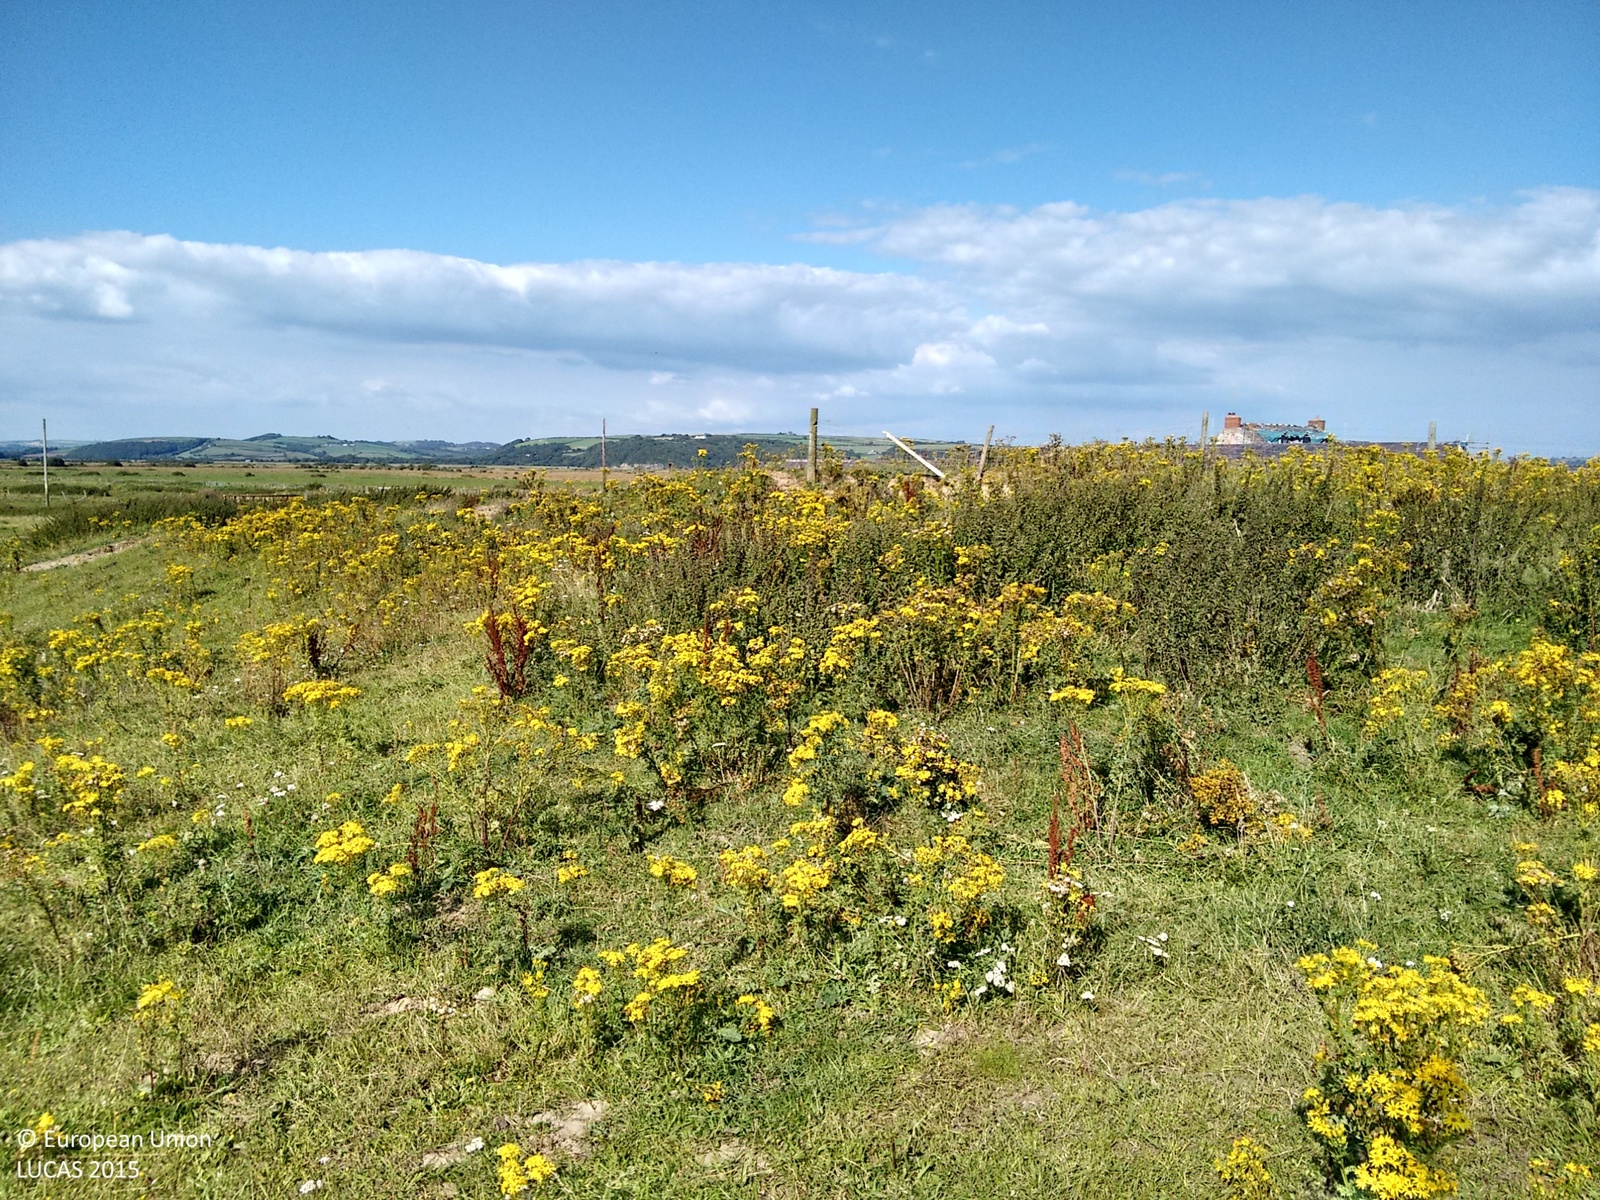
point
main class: Grassland
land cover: Grassland without tree/shrub cover
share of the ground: > 75 %
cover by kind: herbaceous plants 100 %
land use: Agriculture (excluding fallow land and kitchen gardens)
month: August
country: GB
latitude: 51.7420
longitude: -4.4567
